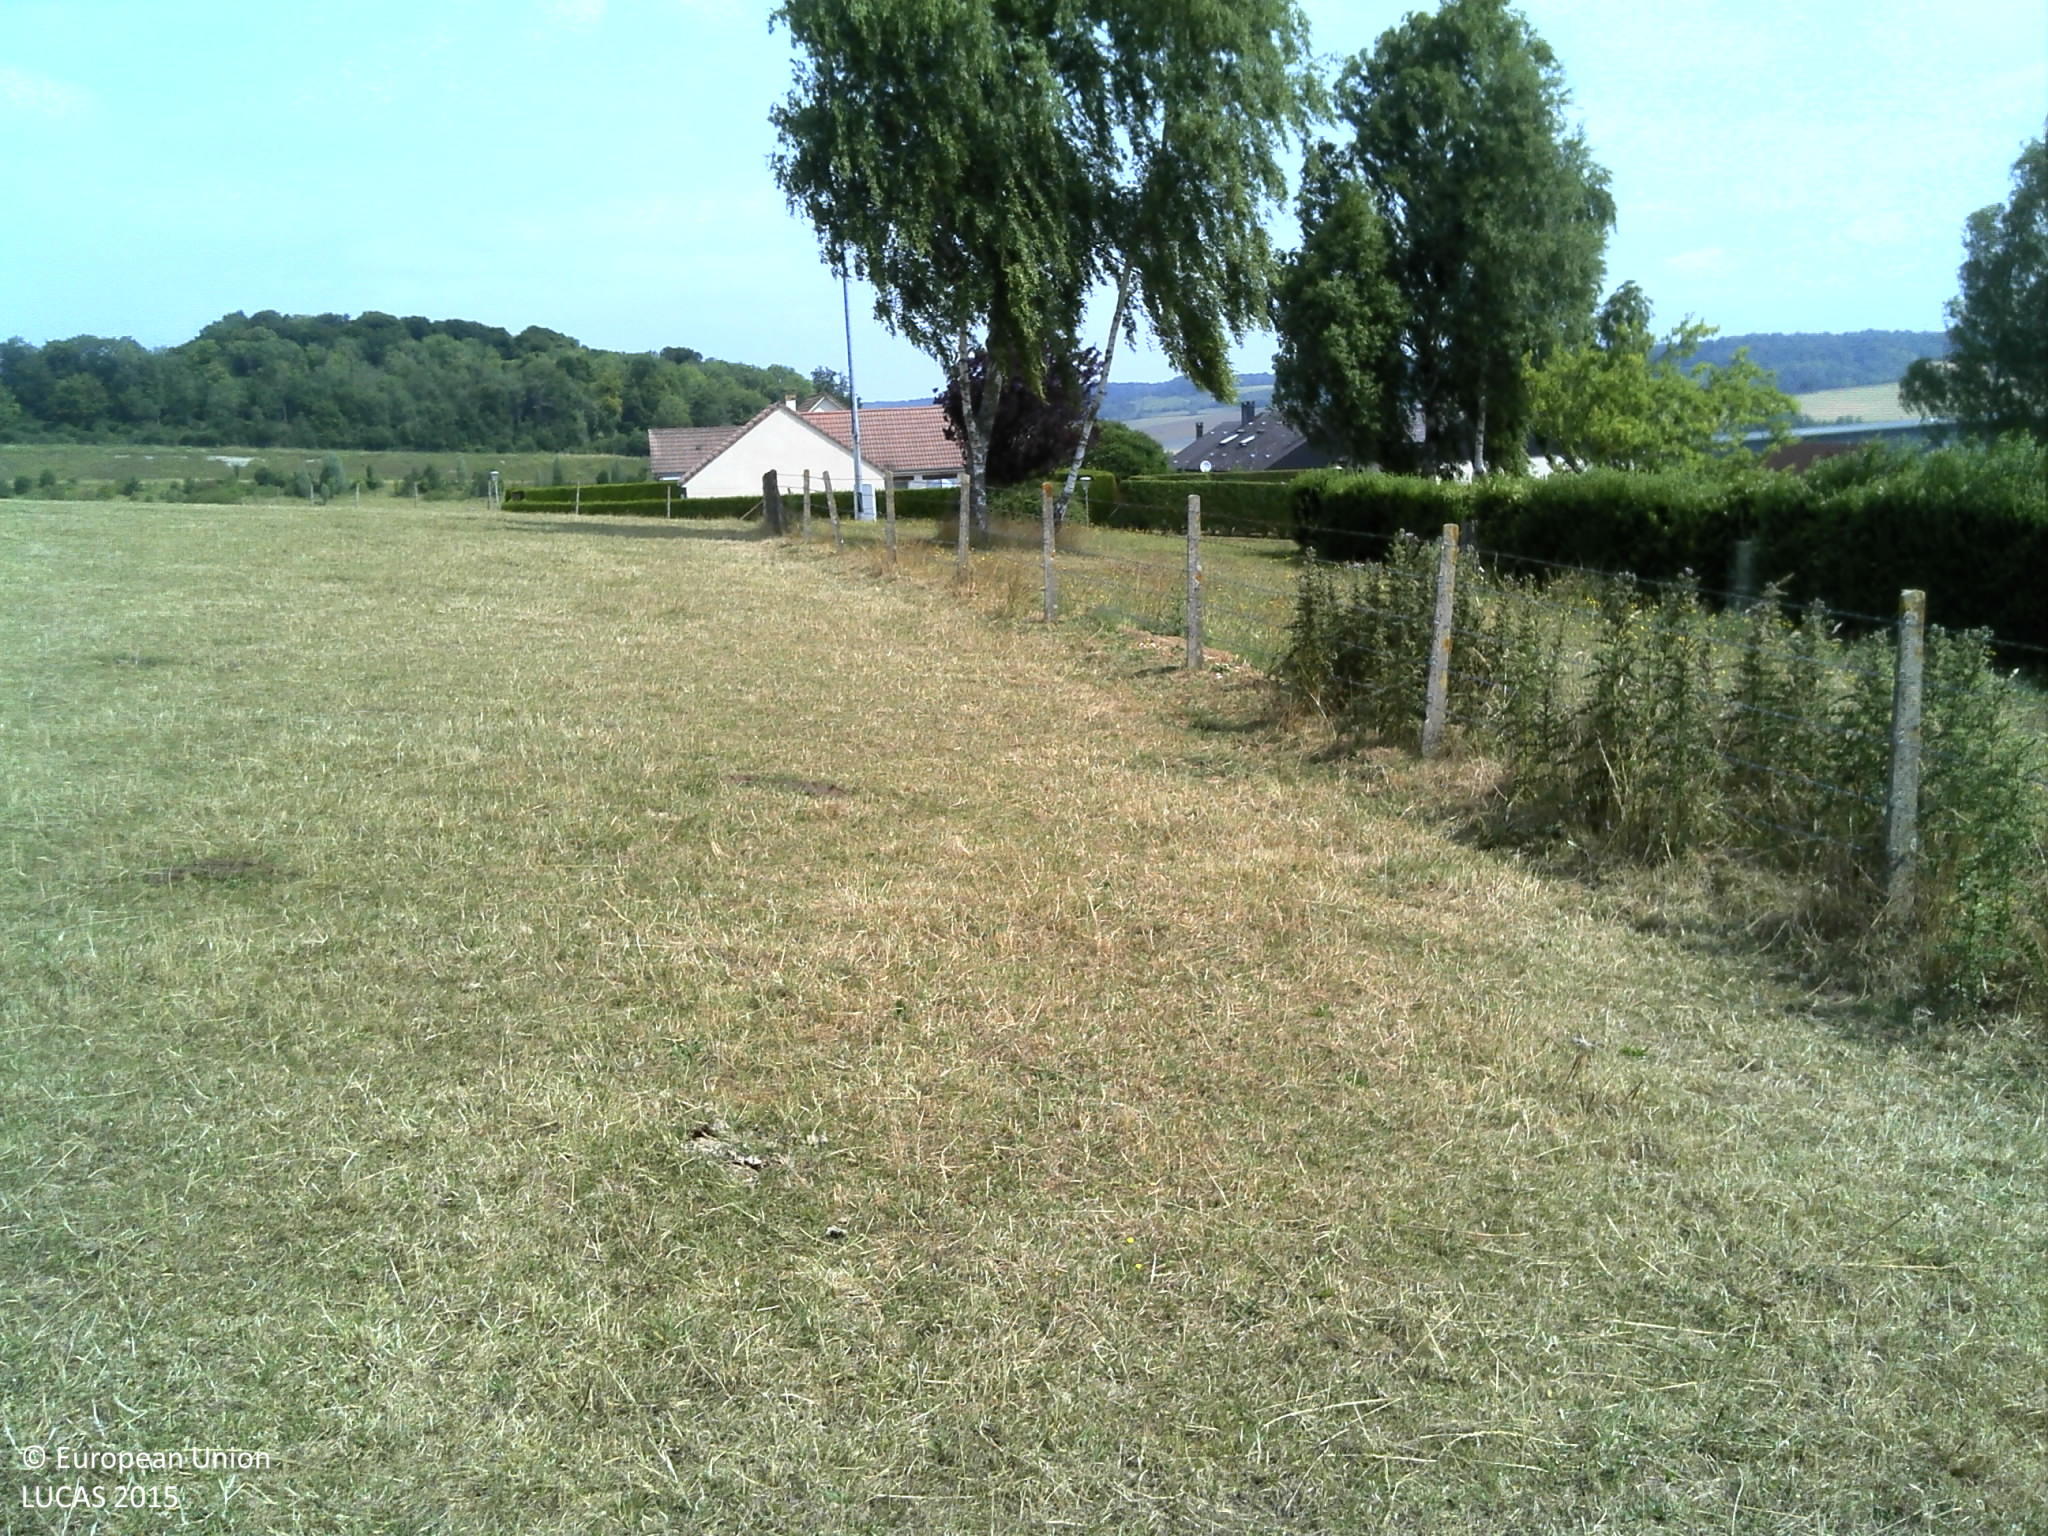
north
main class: Grassland
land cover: Grassland without tree/shrub cover
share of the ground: > 75 %
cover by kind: herbaceous plants 100 %
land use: Agriculture (excluding fallow land and kitchen gardens)
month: July
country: FR
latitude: 49.7763
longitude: 1.7483
